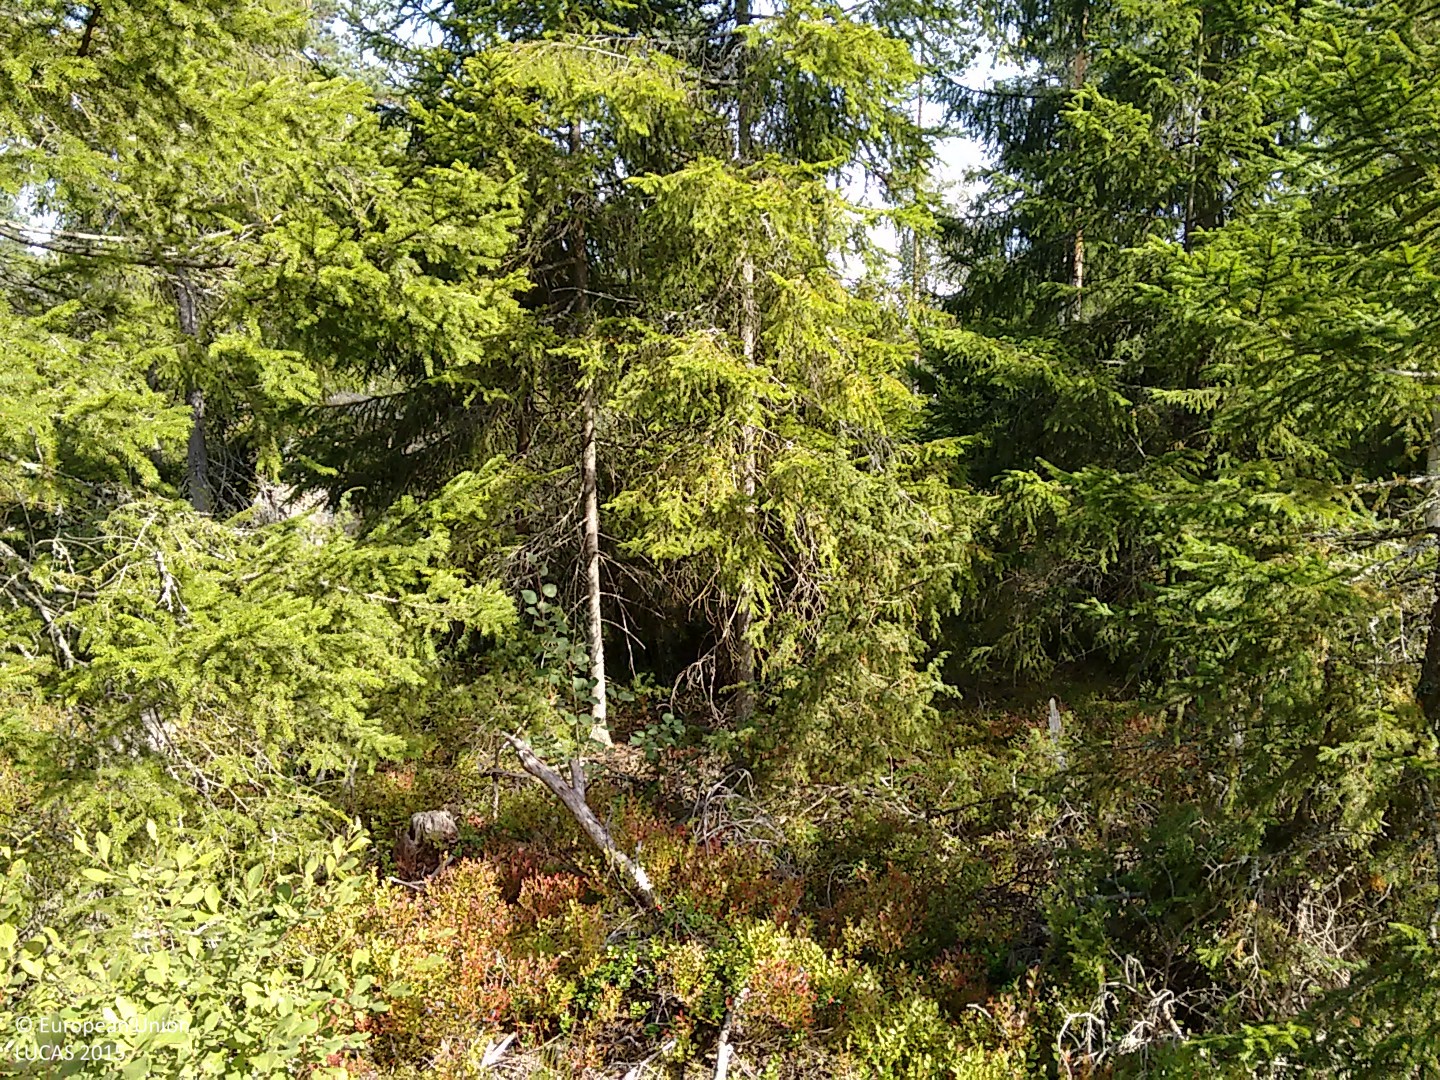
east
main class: Woodland
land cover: Other coniferous woodland
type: hemiboreal forest and nemoral coniferous forest and mixed broadleaved-coniferous forest
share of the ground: > 75 %
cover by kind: coniferous forest trees 70 %, broadleaved forest trees 15 %, herbaceous plants 15 %
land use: Forestry
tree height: > 5 m
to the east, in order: Other coniferous woodland; Ditches and canals; Pine dominated mixed woodland; Tracks; Spruce dominated mixed woodland; Pine dominated mixed woodland
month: September
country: FI
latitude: 60.7369
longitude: 21.6290
